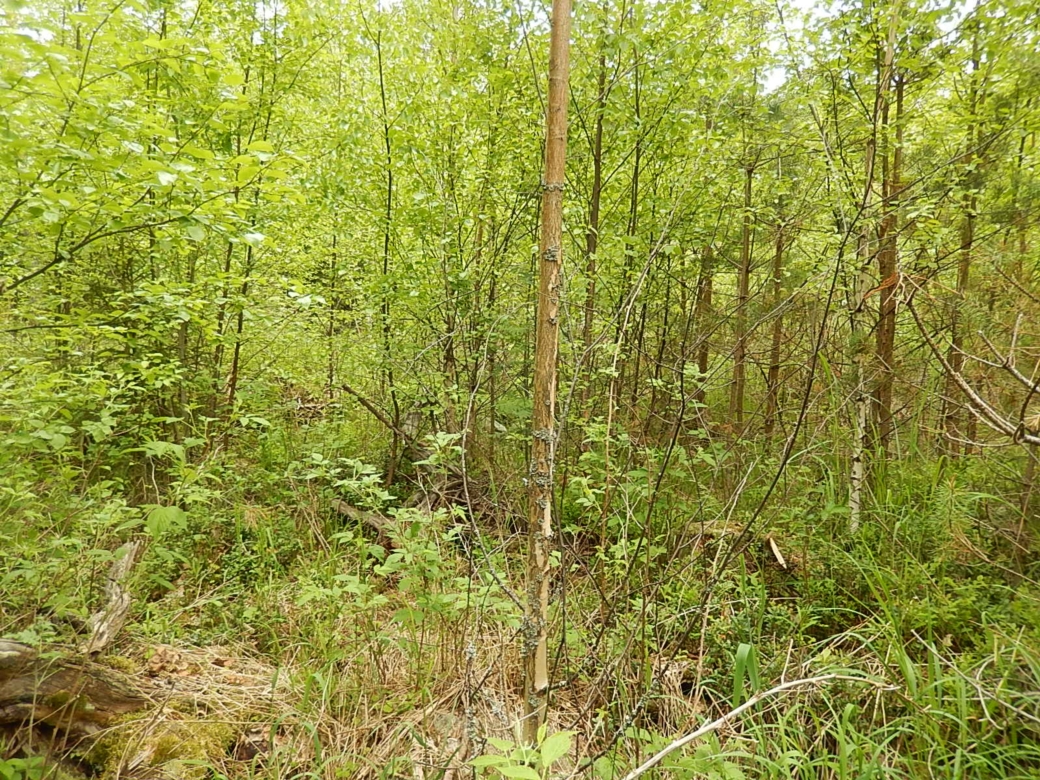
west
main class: Woodland
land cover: Pine dominated mixed woodland
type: boreal forest
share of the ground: > 75 %
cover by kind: broadleaved forest trees 50 %, coniferous forest trees 40 %, shrubs 5 %, herbaceous plants 5 %
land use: Forestry
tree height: > 5 m
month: June
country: FI
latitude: 61.7796
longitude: 21.5944
